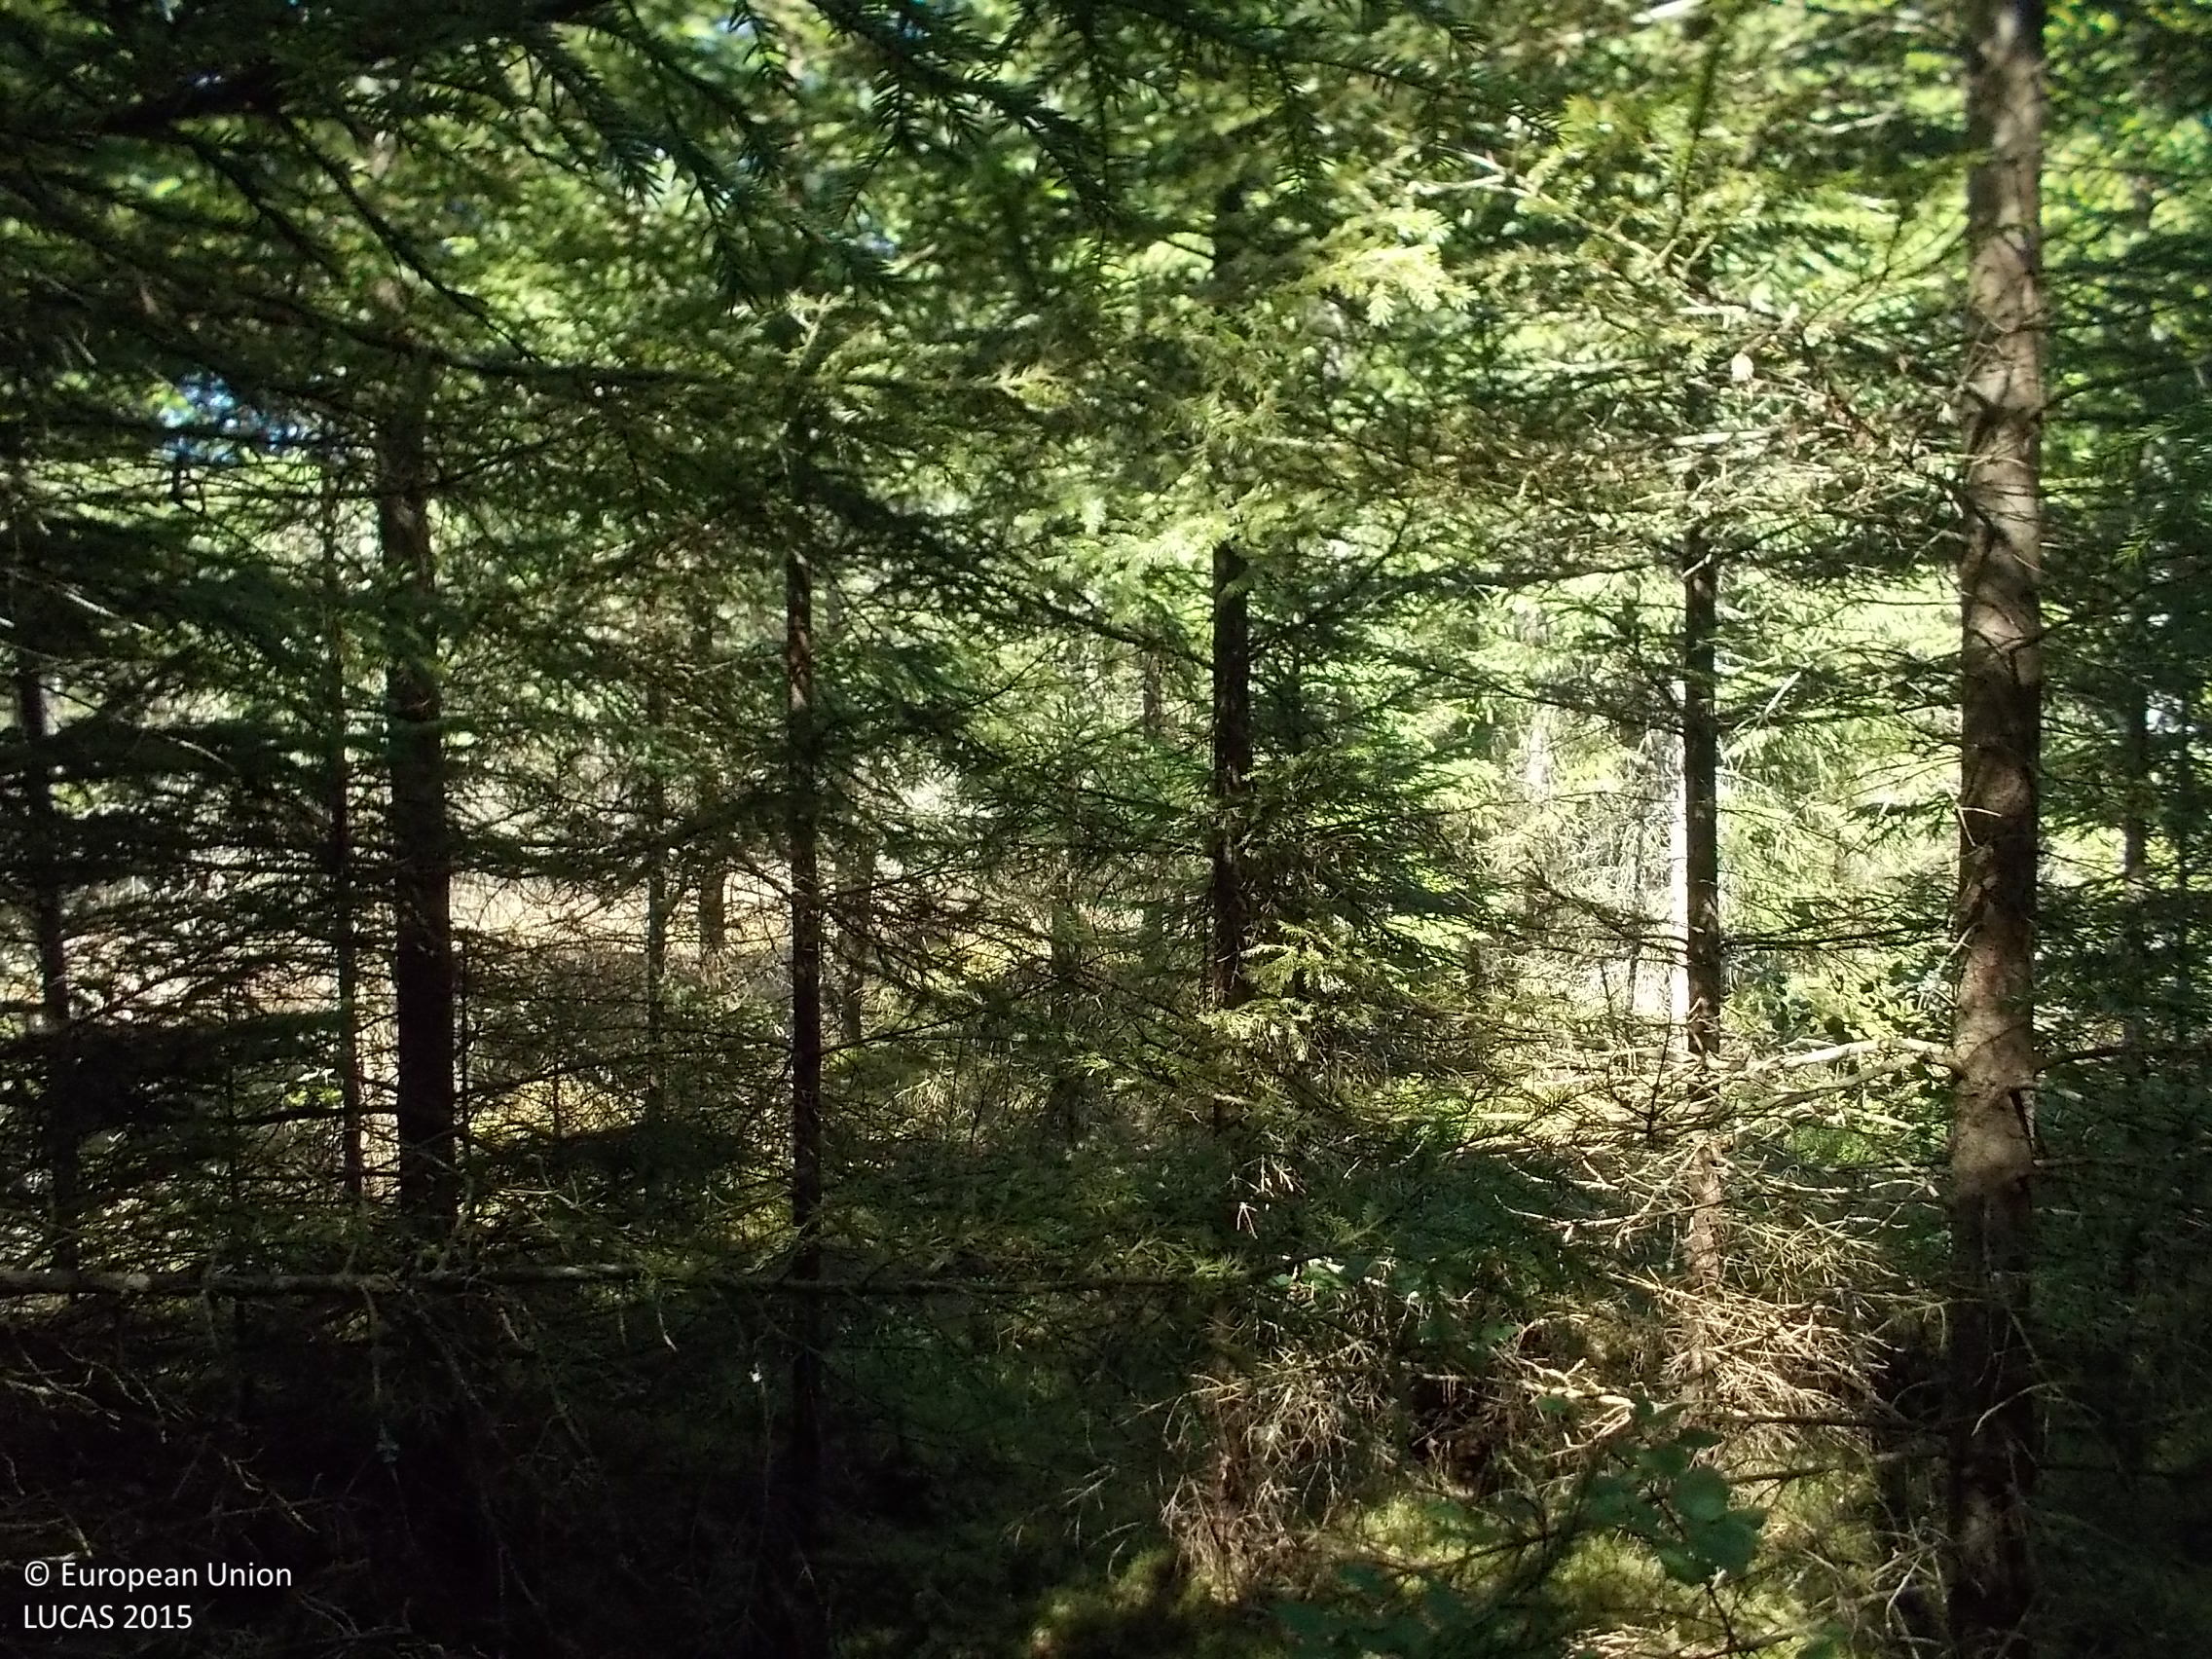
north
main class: Woodland
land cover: Spruce dominated coniferous woodland
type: boreal forest
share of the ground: > 75 %
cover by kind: coniferous forest trees 90 %, shrubs 5 %, lichens and mosses 5 %
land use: Forestry
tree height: > 5 m
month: August
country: SE
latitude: 57.5142
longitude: 13.2509
